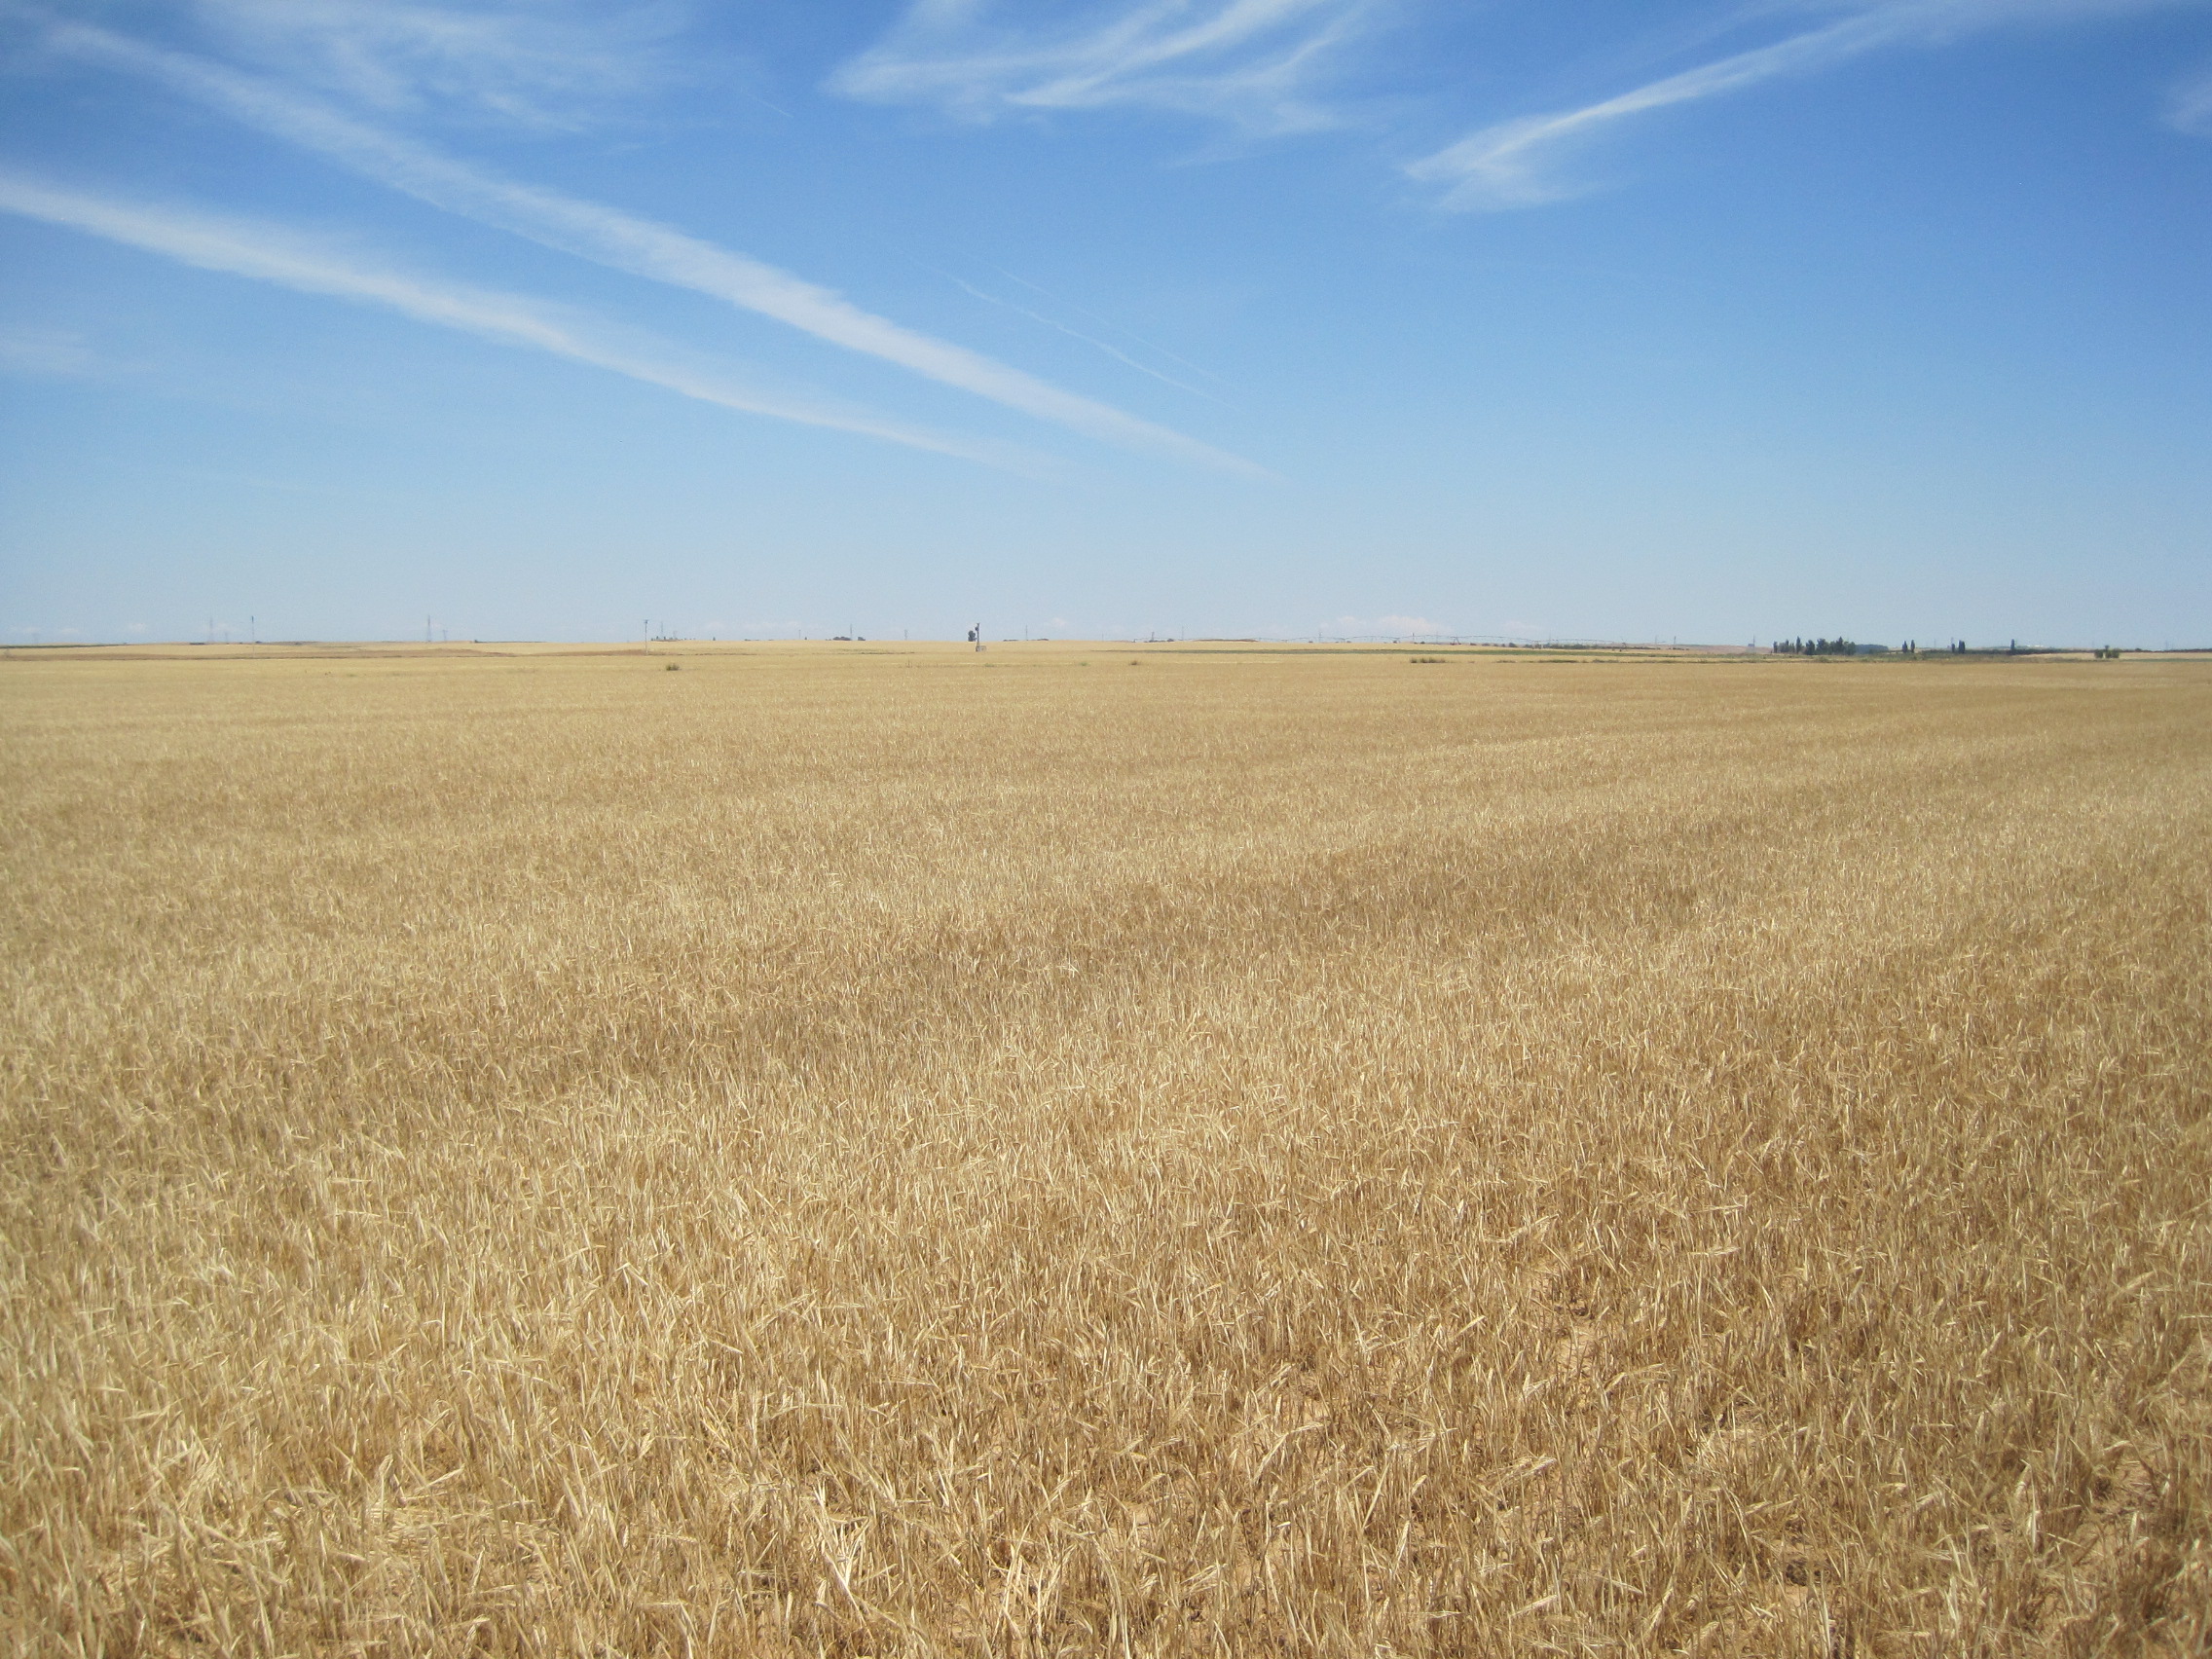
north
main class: Cropland
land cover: Barley
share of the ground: > 75 %
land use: Agriculture (excluding fallow land and kitchen gardens)
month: June
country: ES
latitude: 41.8270
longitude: -5.2149
